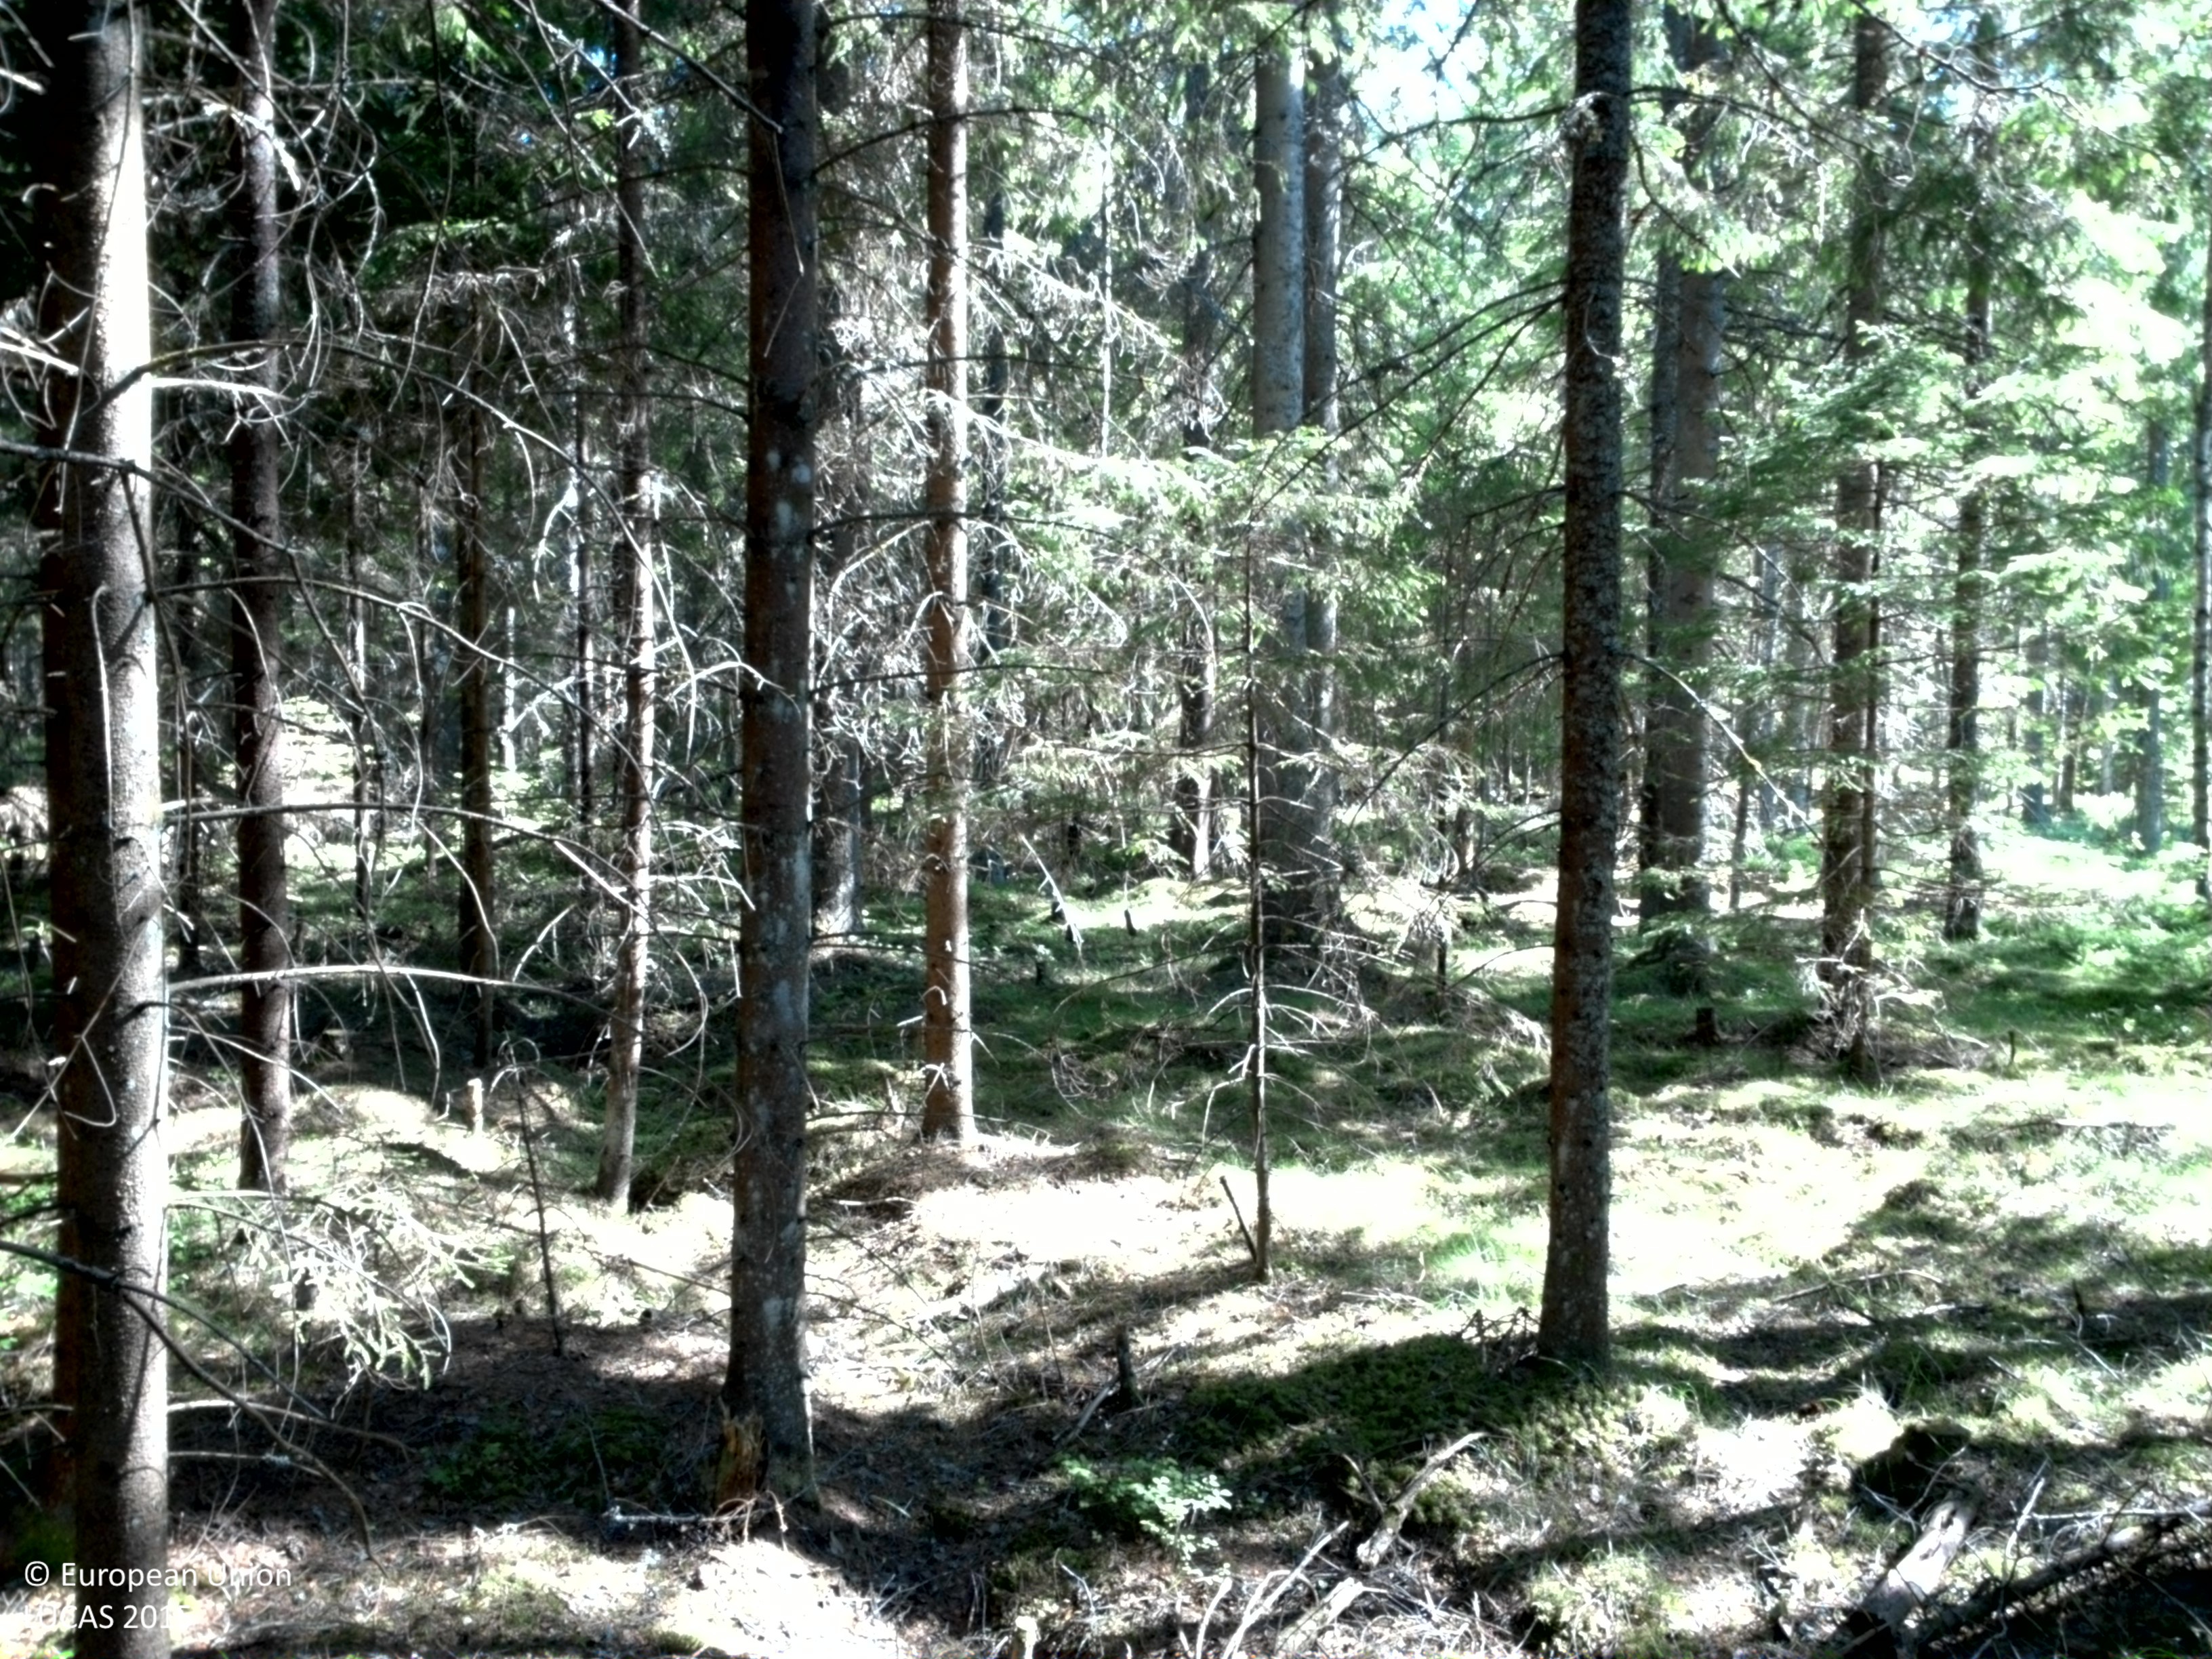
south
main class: Woodland
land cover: Spruce dominated coniferous woodland
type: boreal forest
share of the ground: > 75 %
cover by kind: coniferous forest trees 90 %, broadleaved forest trees 5 %, lichens and mosses 5 %
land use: Forestry
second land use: Community services
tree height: > 5 m
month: June
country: SE
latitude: 58.5941
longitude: 14.5183
